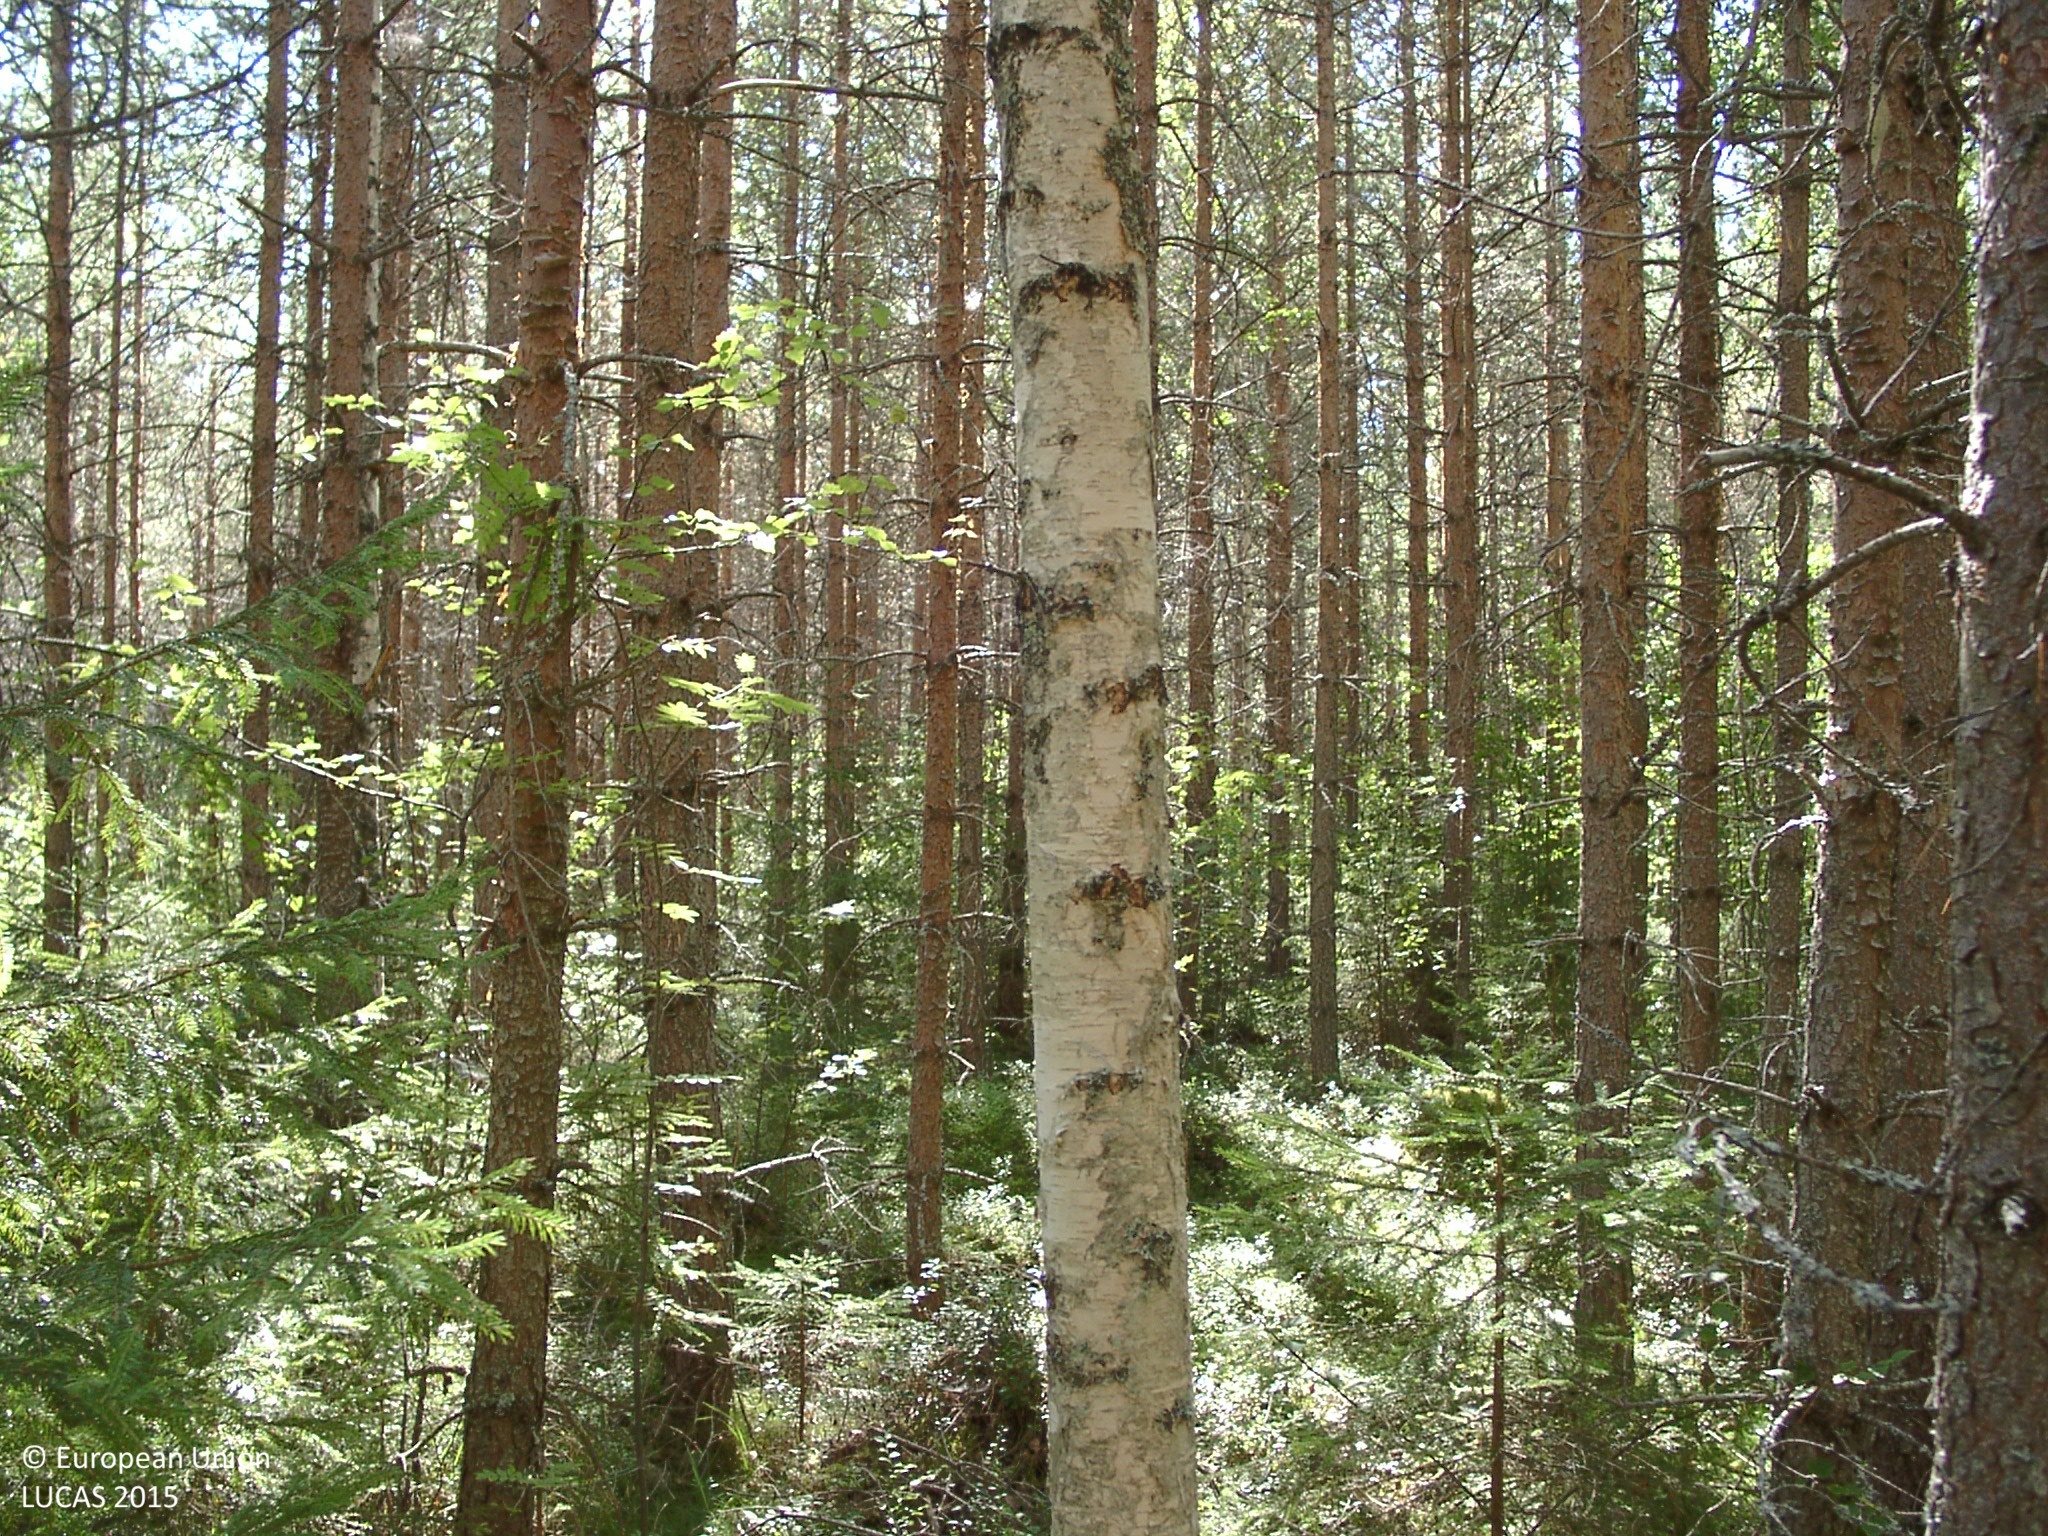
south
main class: Woodland
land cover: Pine dominated coniferous woodland
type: boreal forest
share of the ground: > 75 %
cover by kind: coniferous forest trees 75 %, broadleaved forest trees 10 %, shrubs 10 %, herbaceous plants 5 %
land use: Forestry
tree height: > 5 m
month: August
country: FI
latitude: 62.4423
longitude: 25.1985
